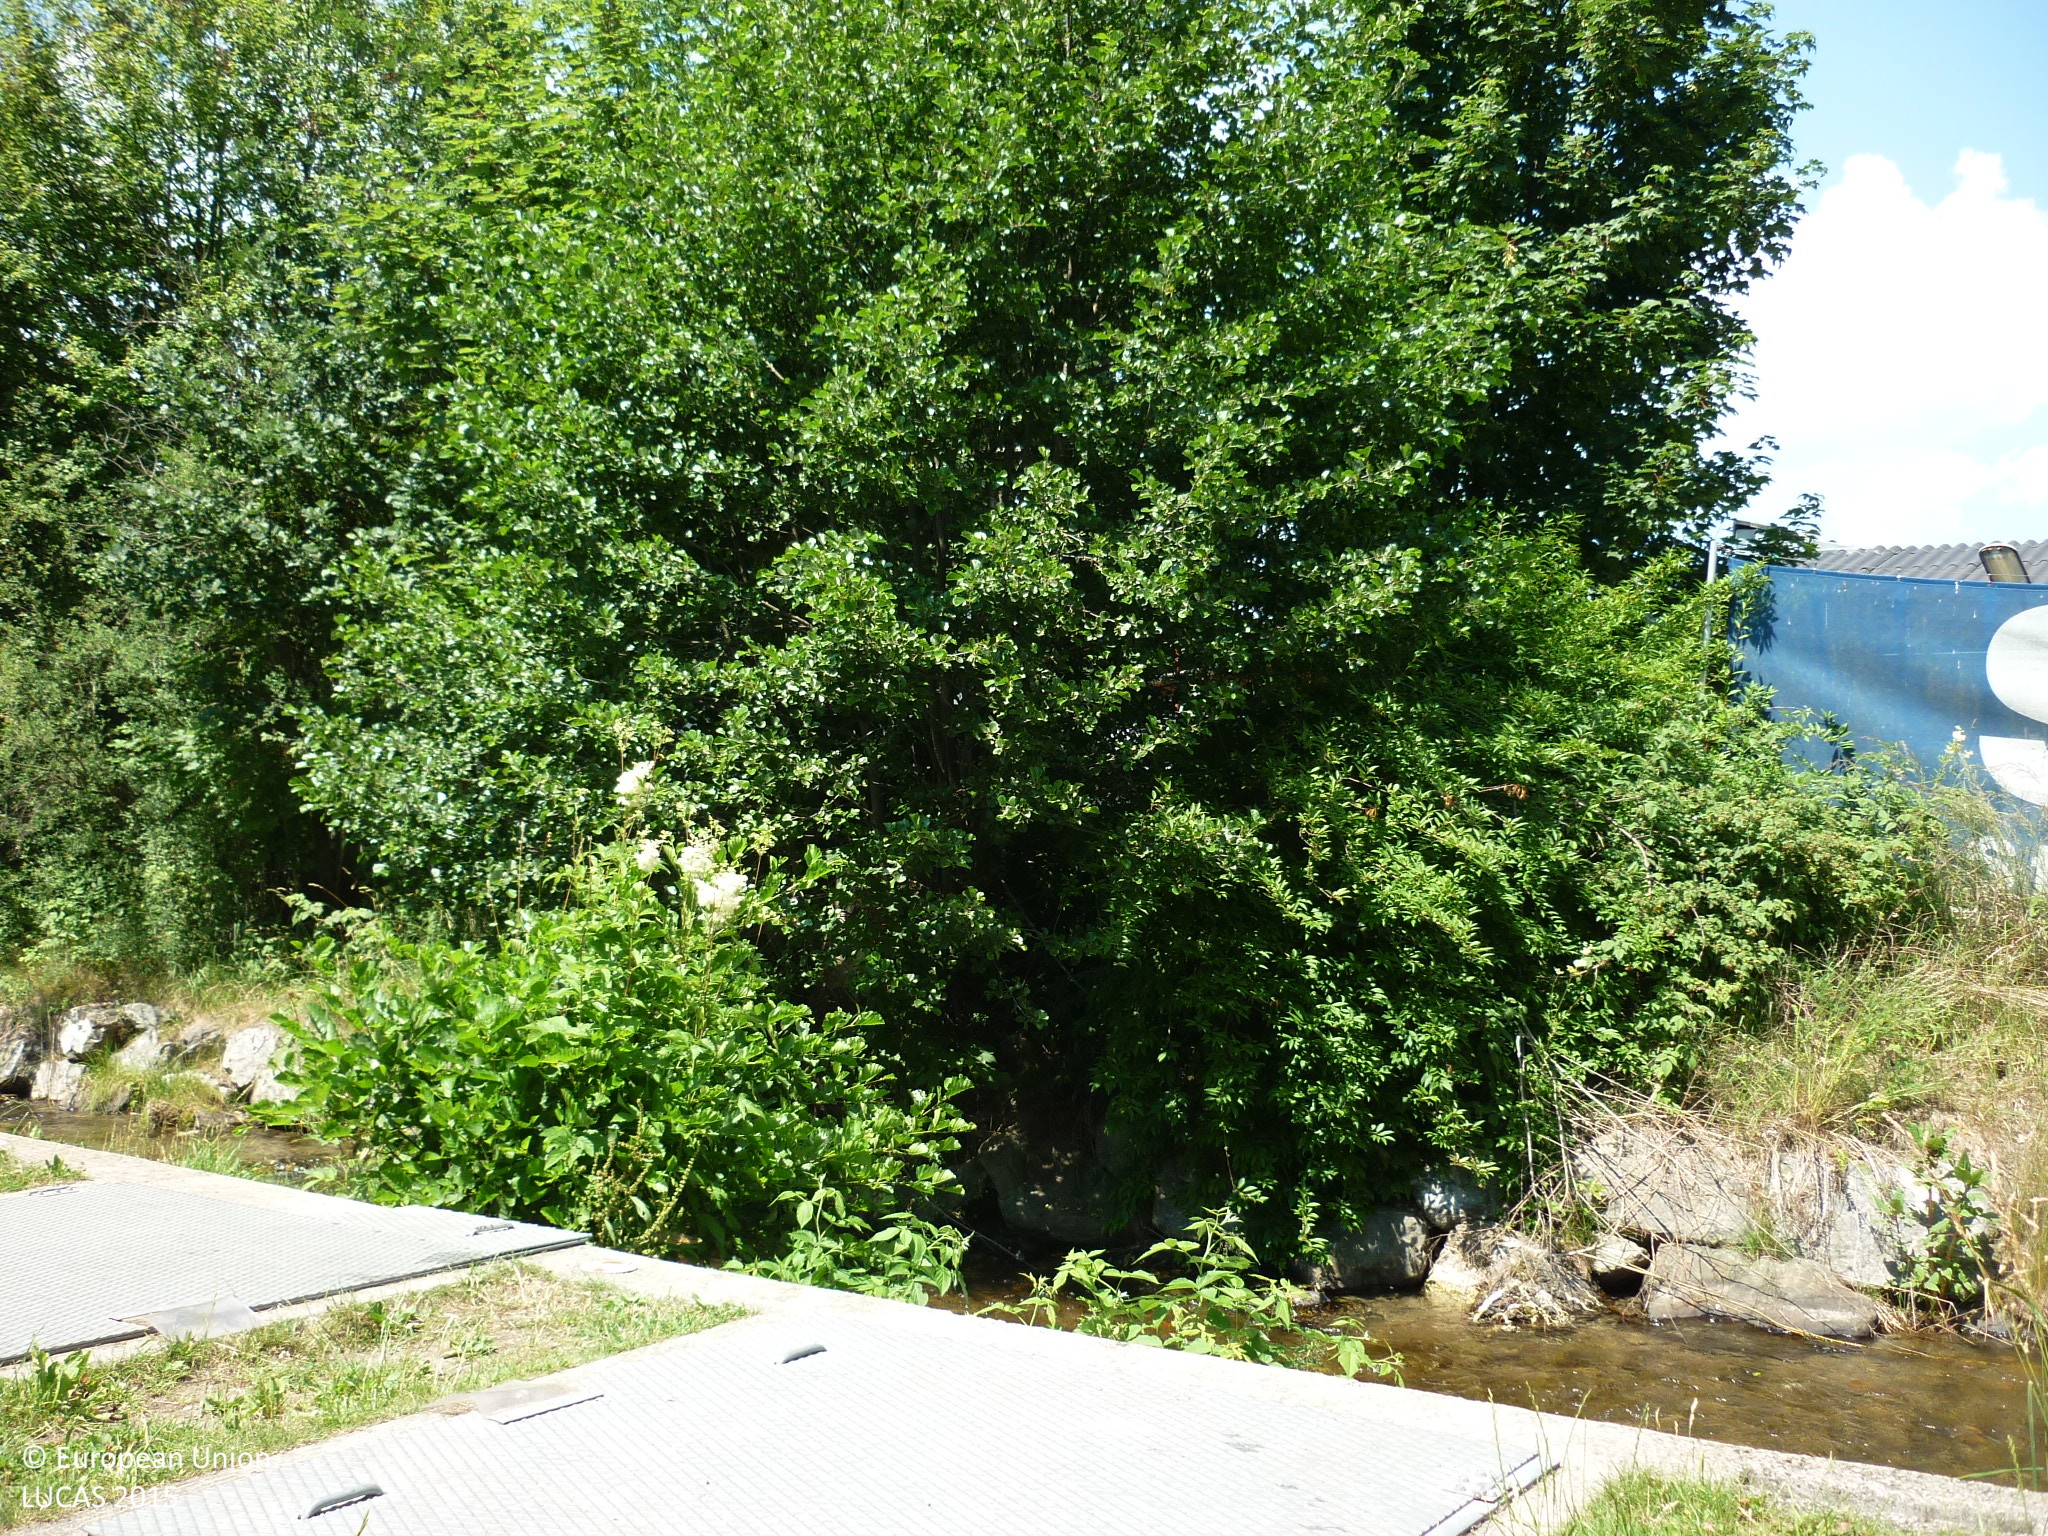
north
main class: Grassland
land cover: Grassland without tree/shrub cover
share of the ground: > 75 %
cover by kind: herbaceous plants 100 %
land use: Amenities, museums, leisure
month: July
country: AT
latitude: 47.2167
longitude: 14.8187
